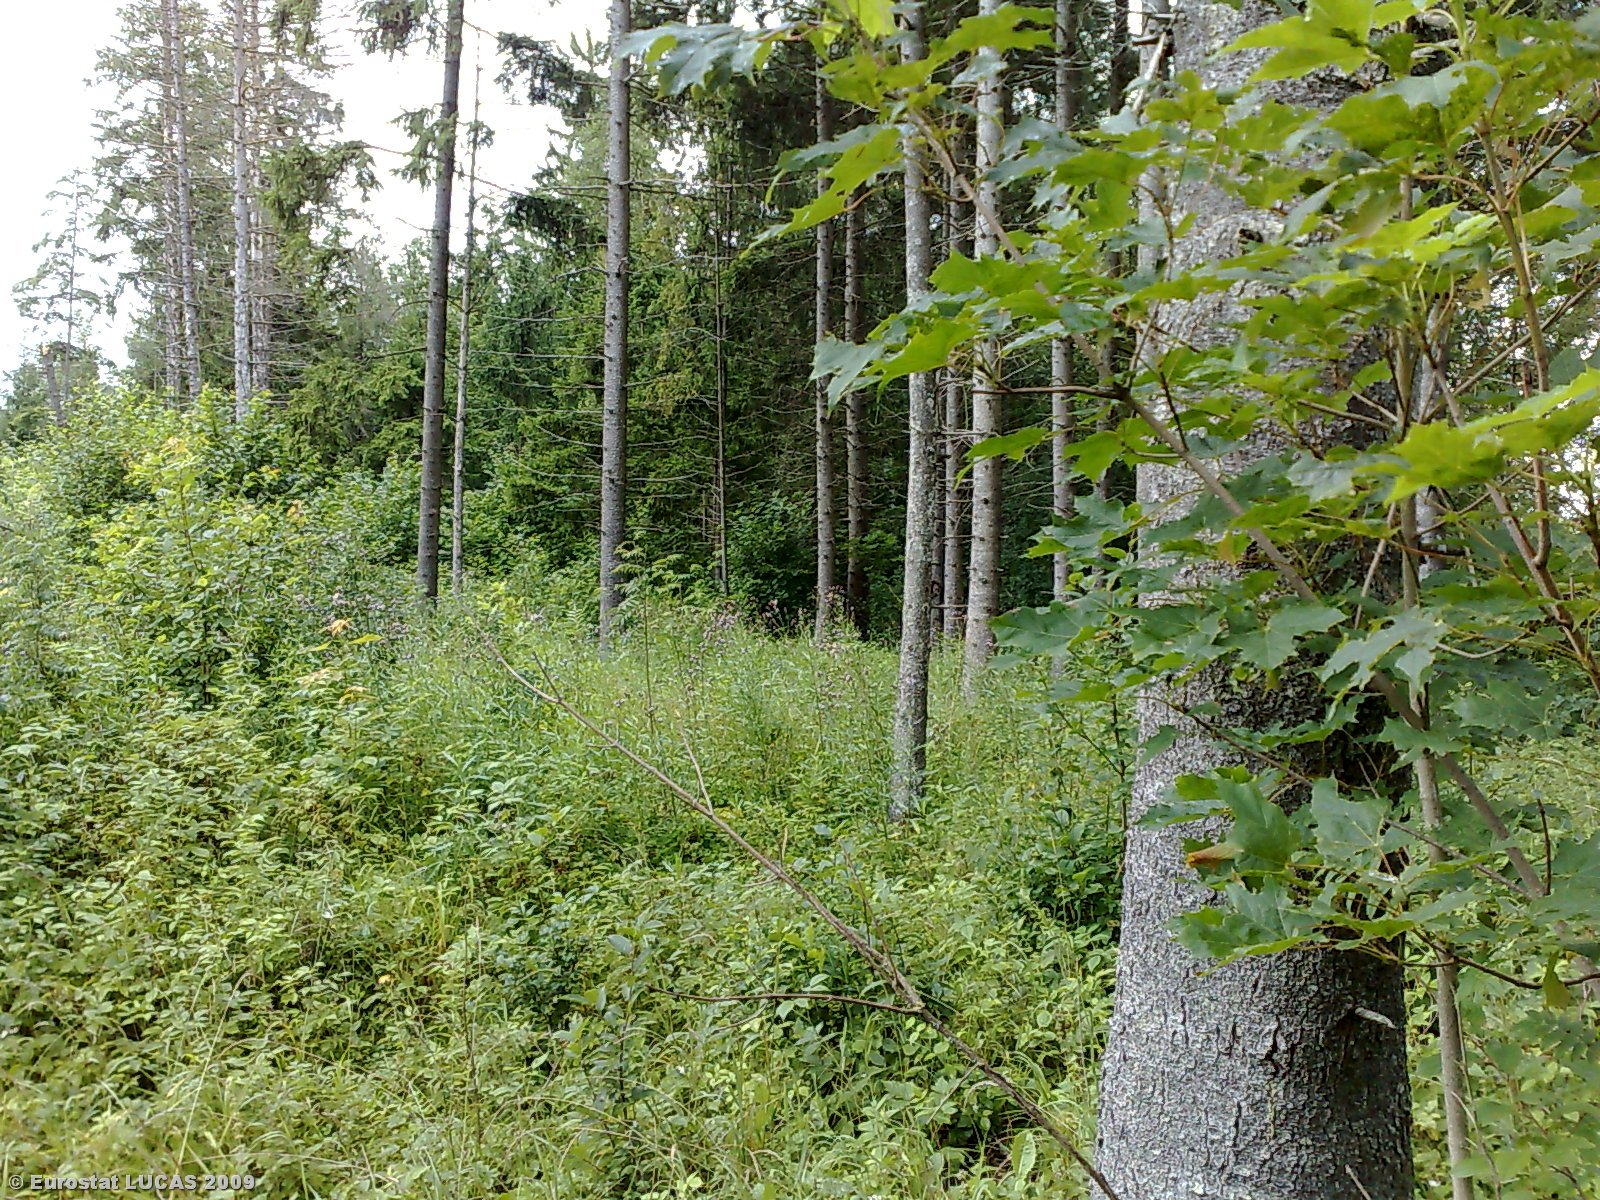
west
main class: Woodland
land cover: Mixed woodland
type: boreal forest
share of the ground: 25 - 50 %
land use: Forestry
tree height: > 5 m
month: July
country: LT
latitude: 56.2417
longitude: 22.9257
